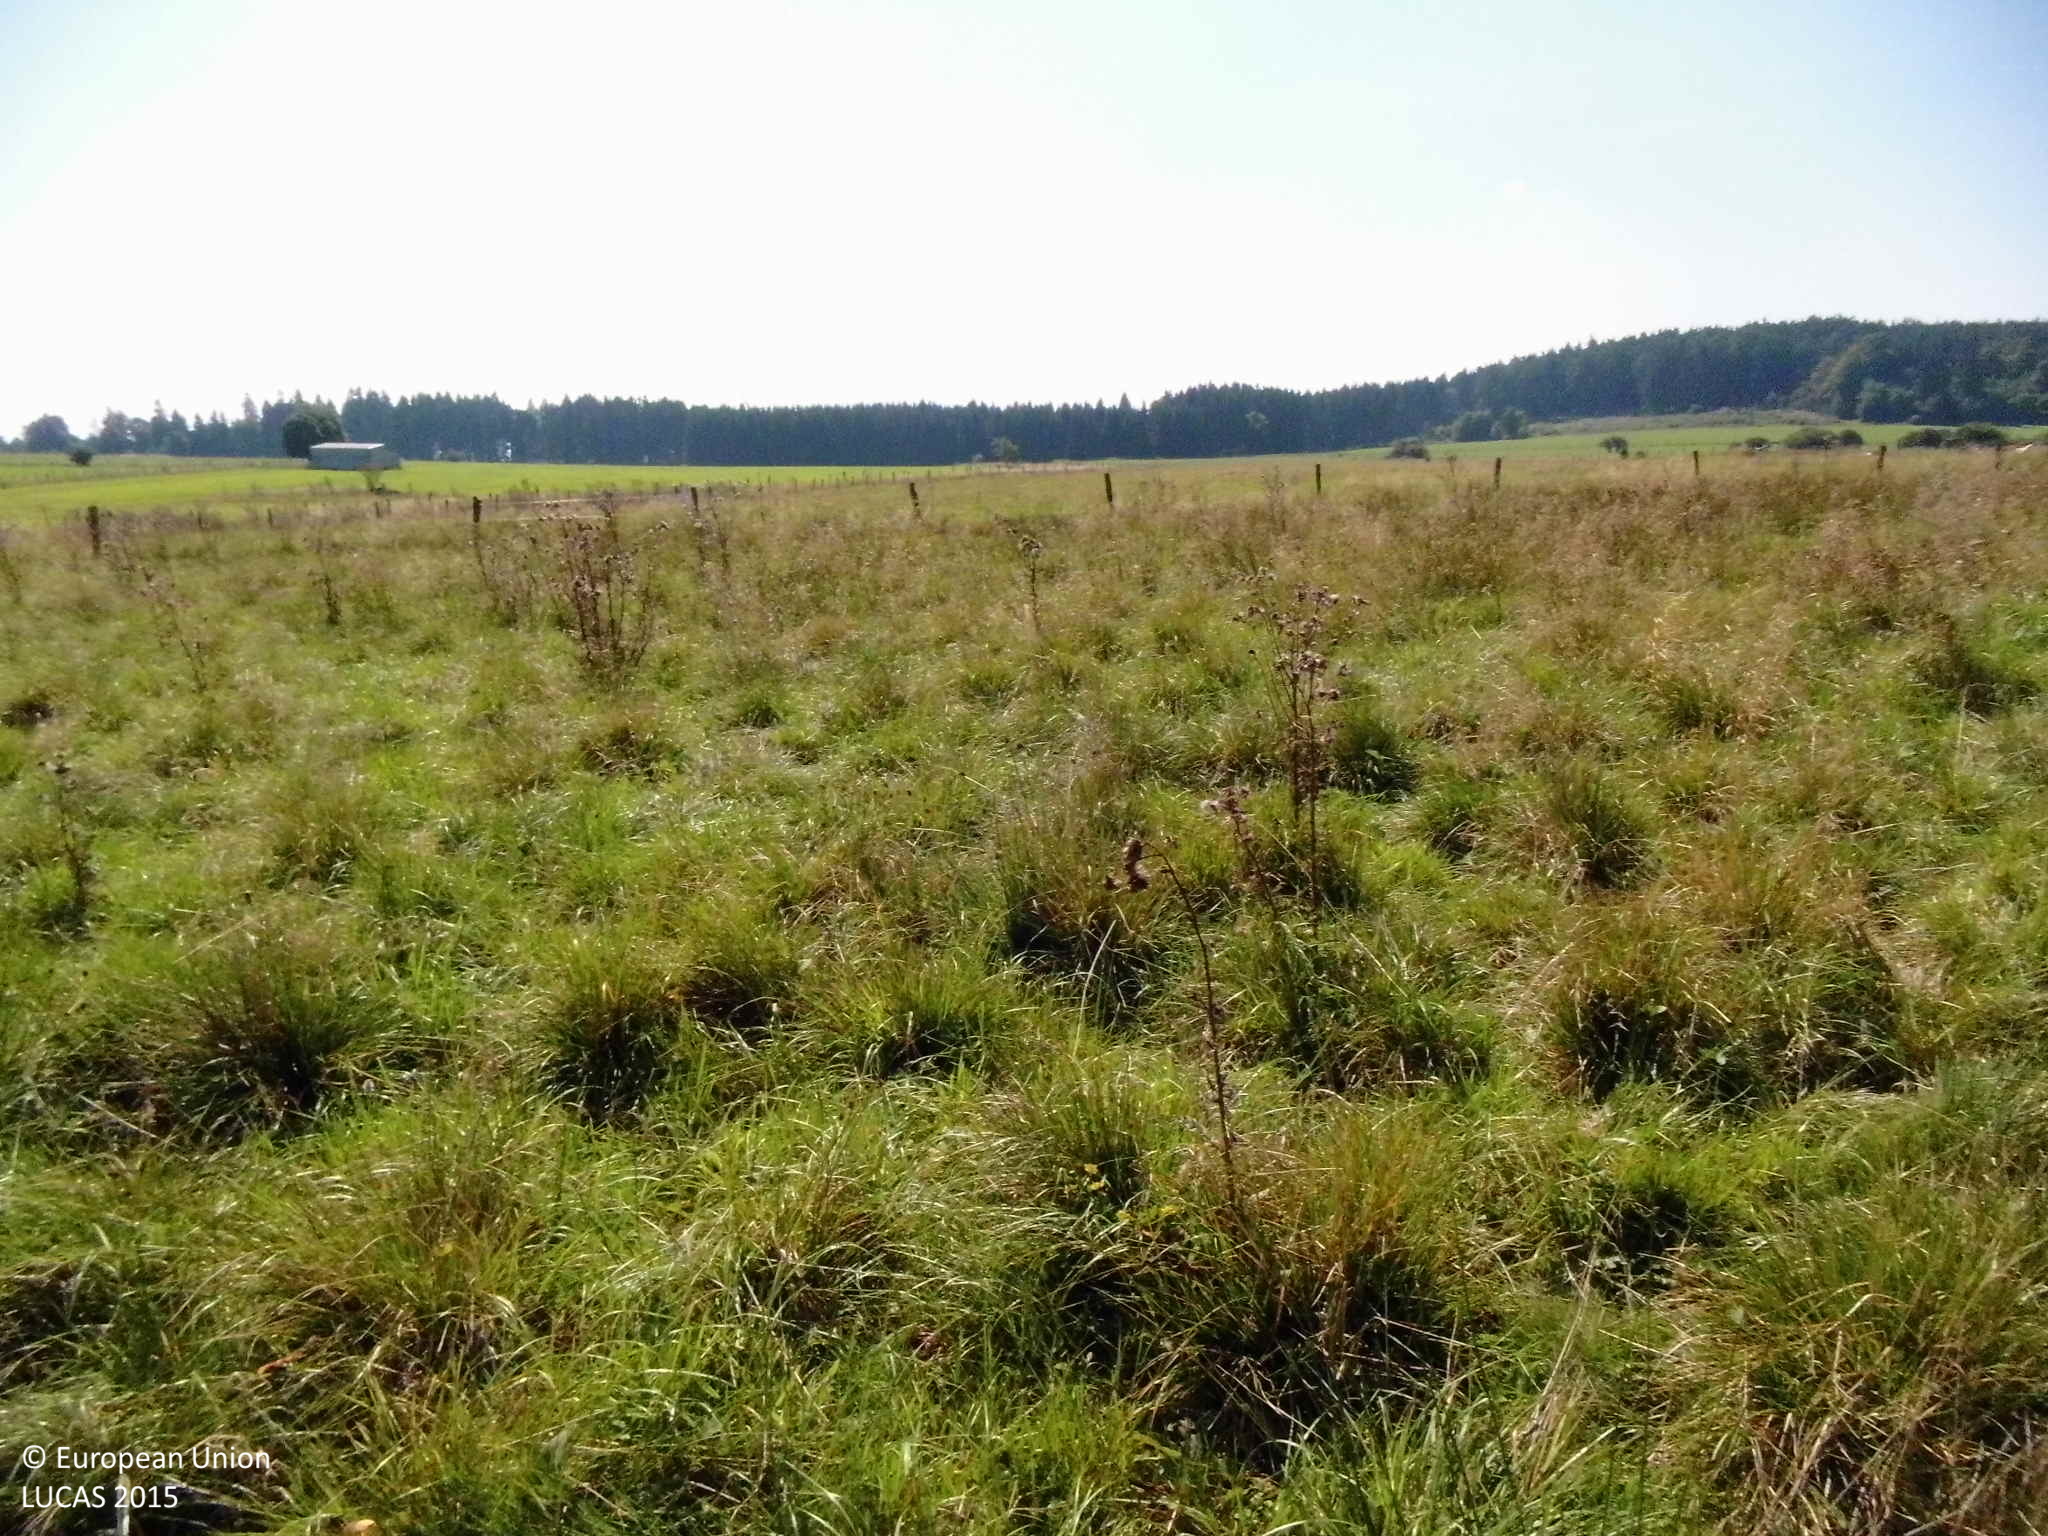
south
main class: Grassland
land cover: Spontaneously vegetated surfaces
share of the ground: > 75 %
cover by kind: herbaceous plants 95 %, shrubs 5 %
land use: Fallow land
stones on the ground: < 10 %
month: August
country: DE
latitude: 50.6723
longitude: 8.1184
